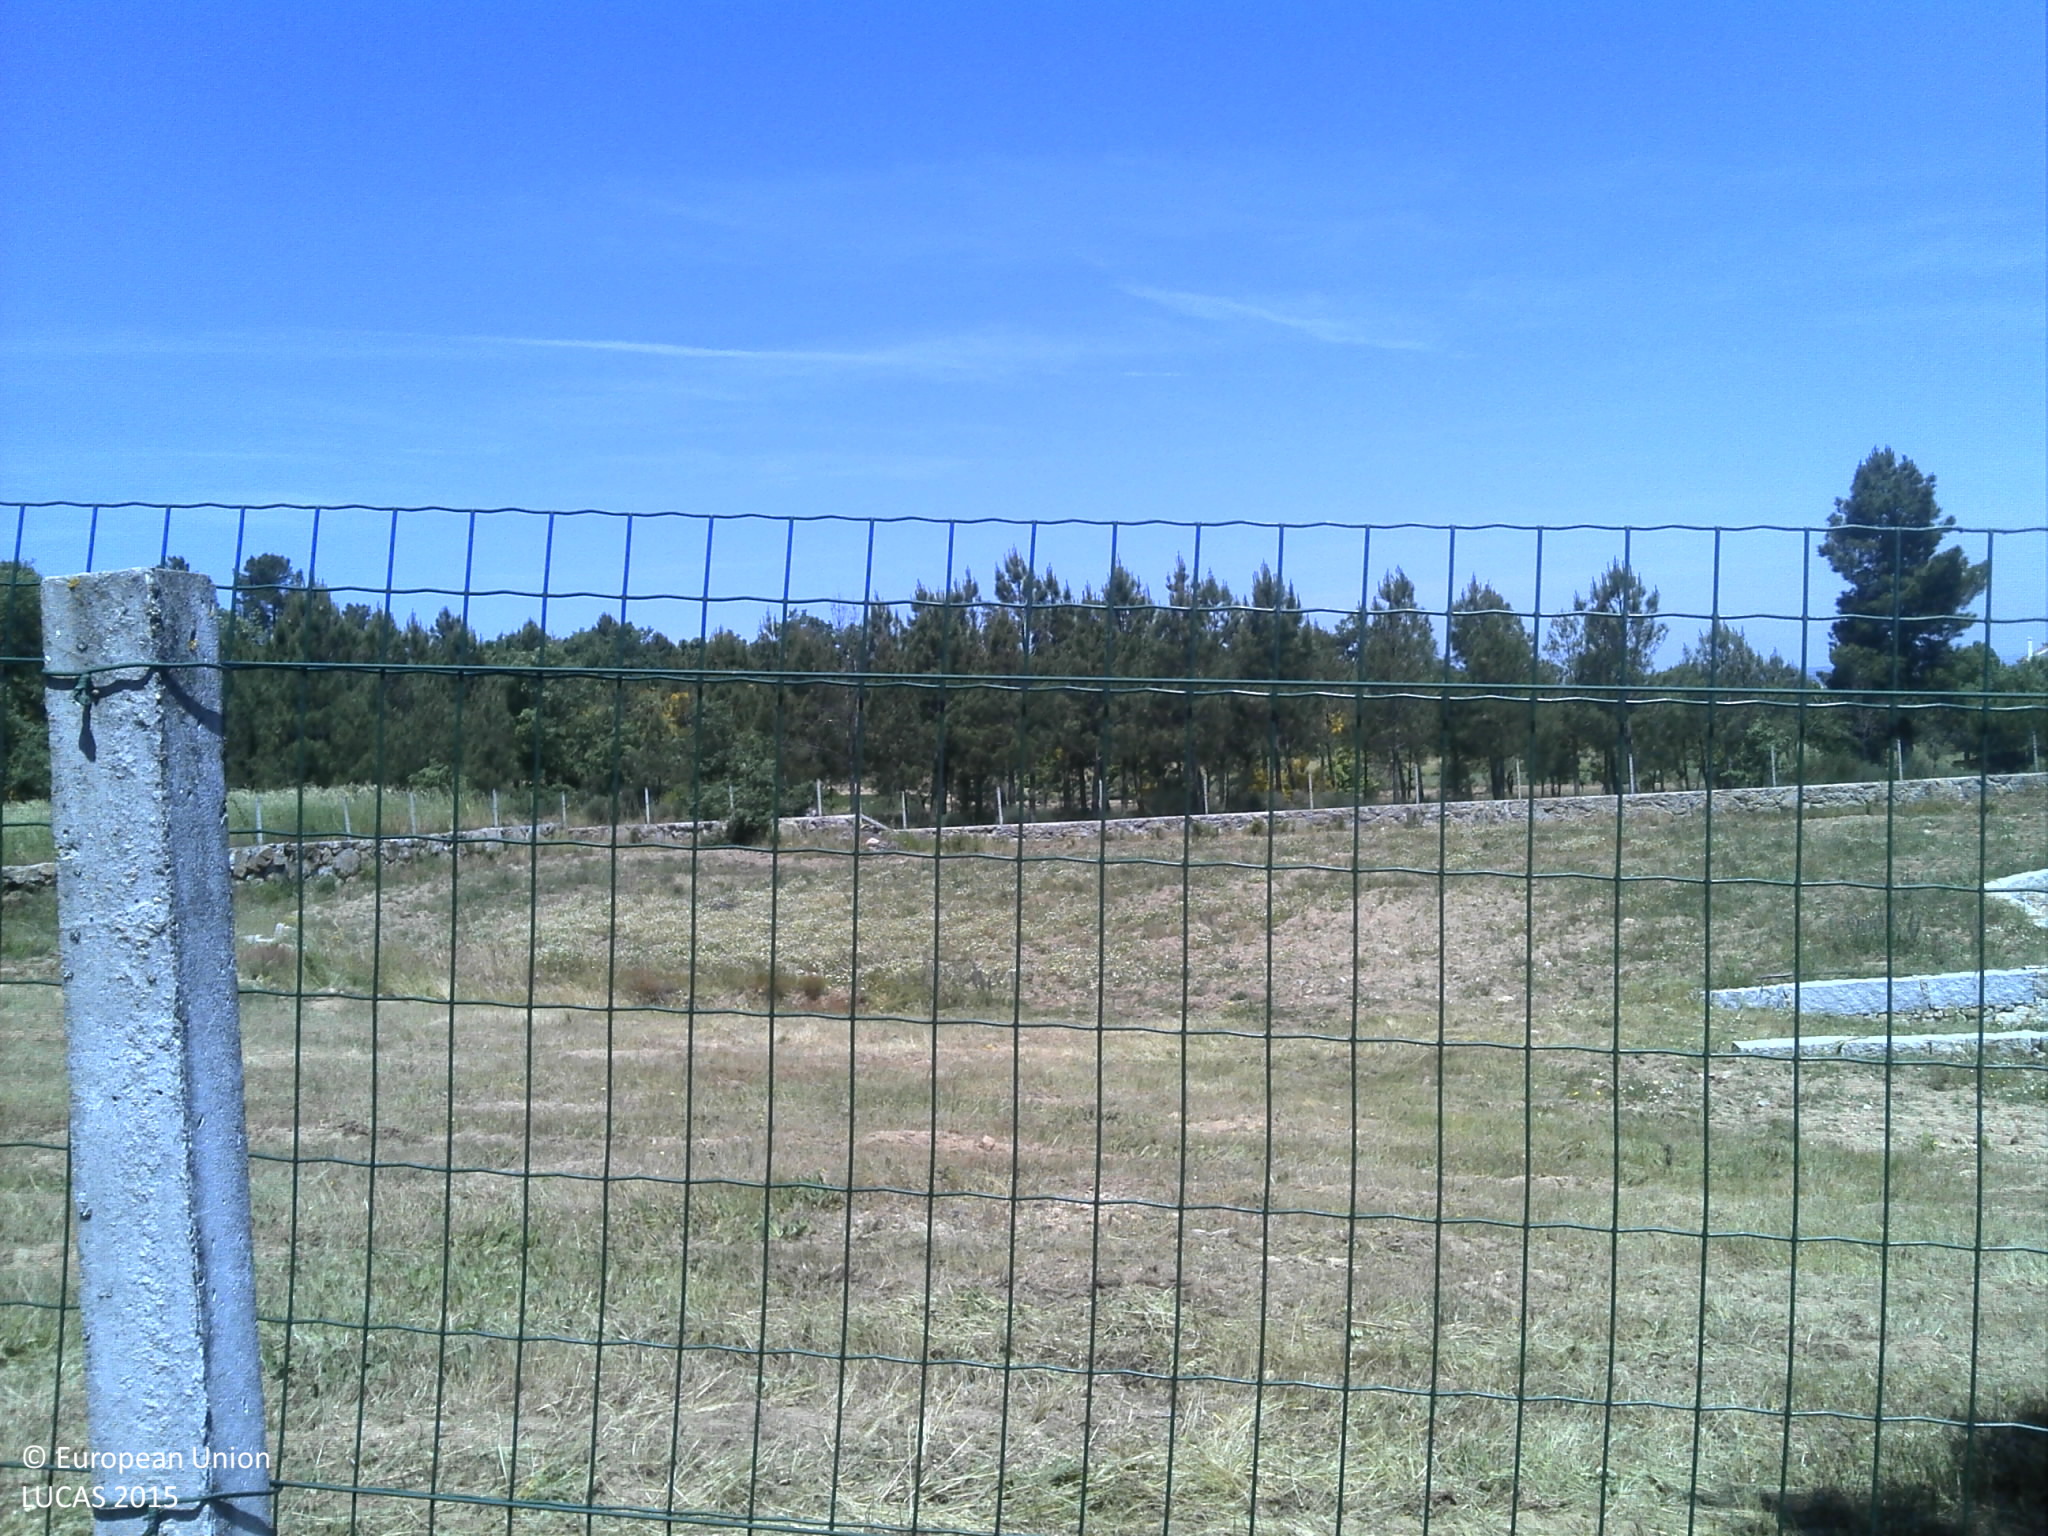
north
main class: Grassland
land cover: Grassland without tree/shrub cover
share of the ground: 25 - 50 %
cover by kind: herbaceous plants 50 %, consolidated bare surface 40 %
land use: Agriculture (excluding fallow land and kitchen gardens)
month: May
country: PT
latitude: 40.6461
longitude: -7.2421
